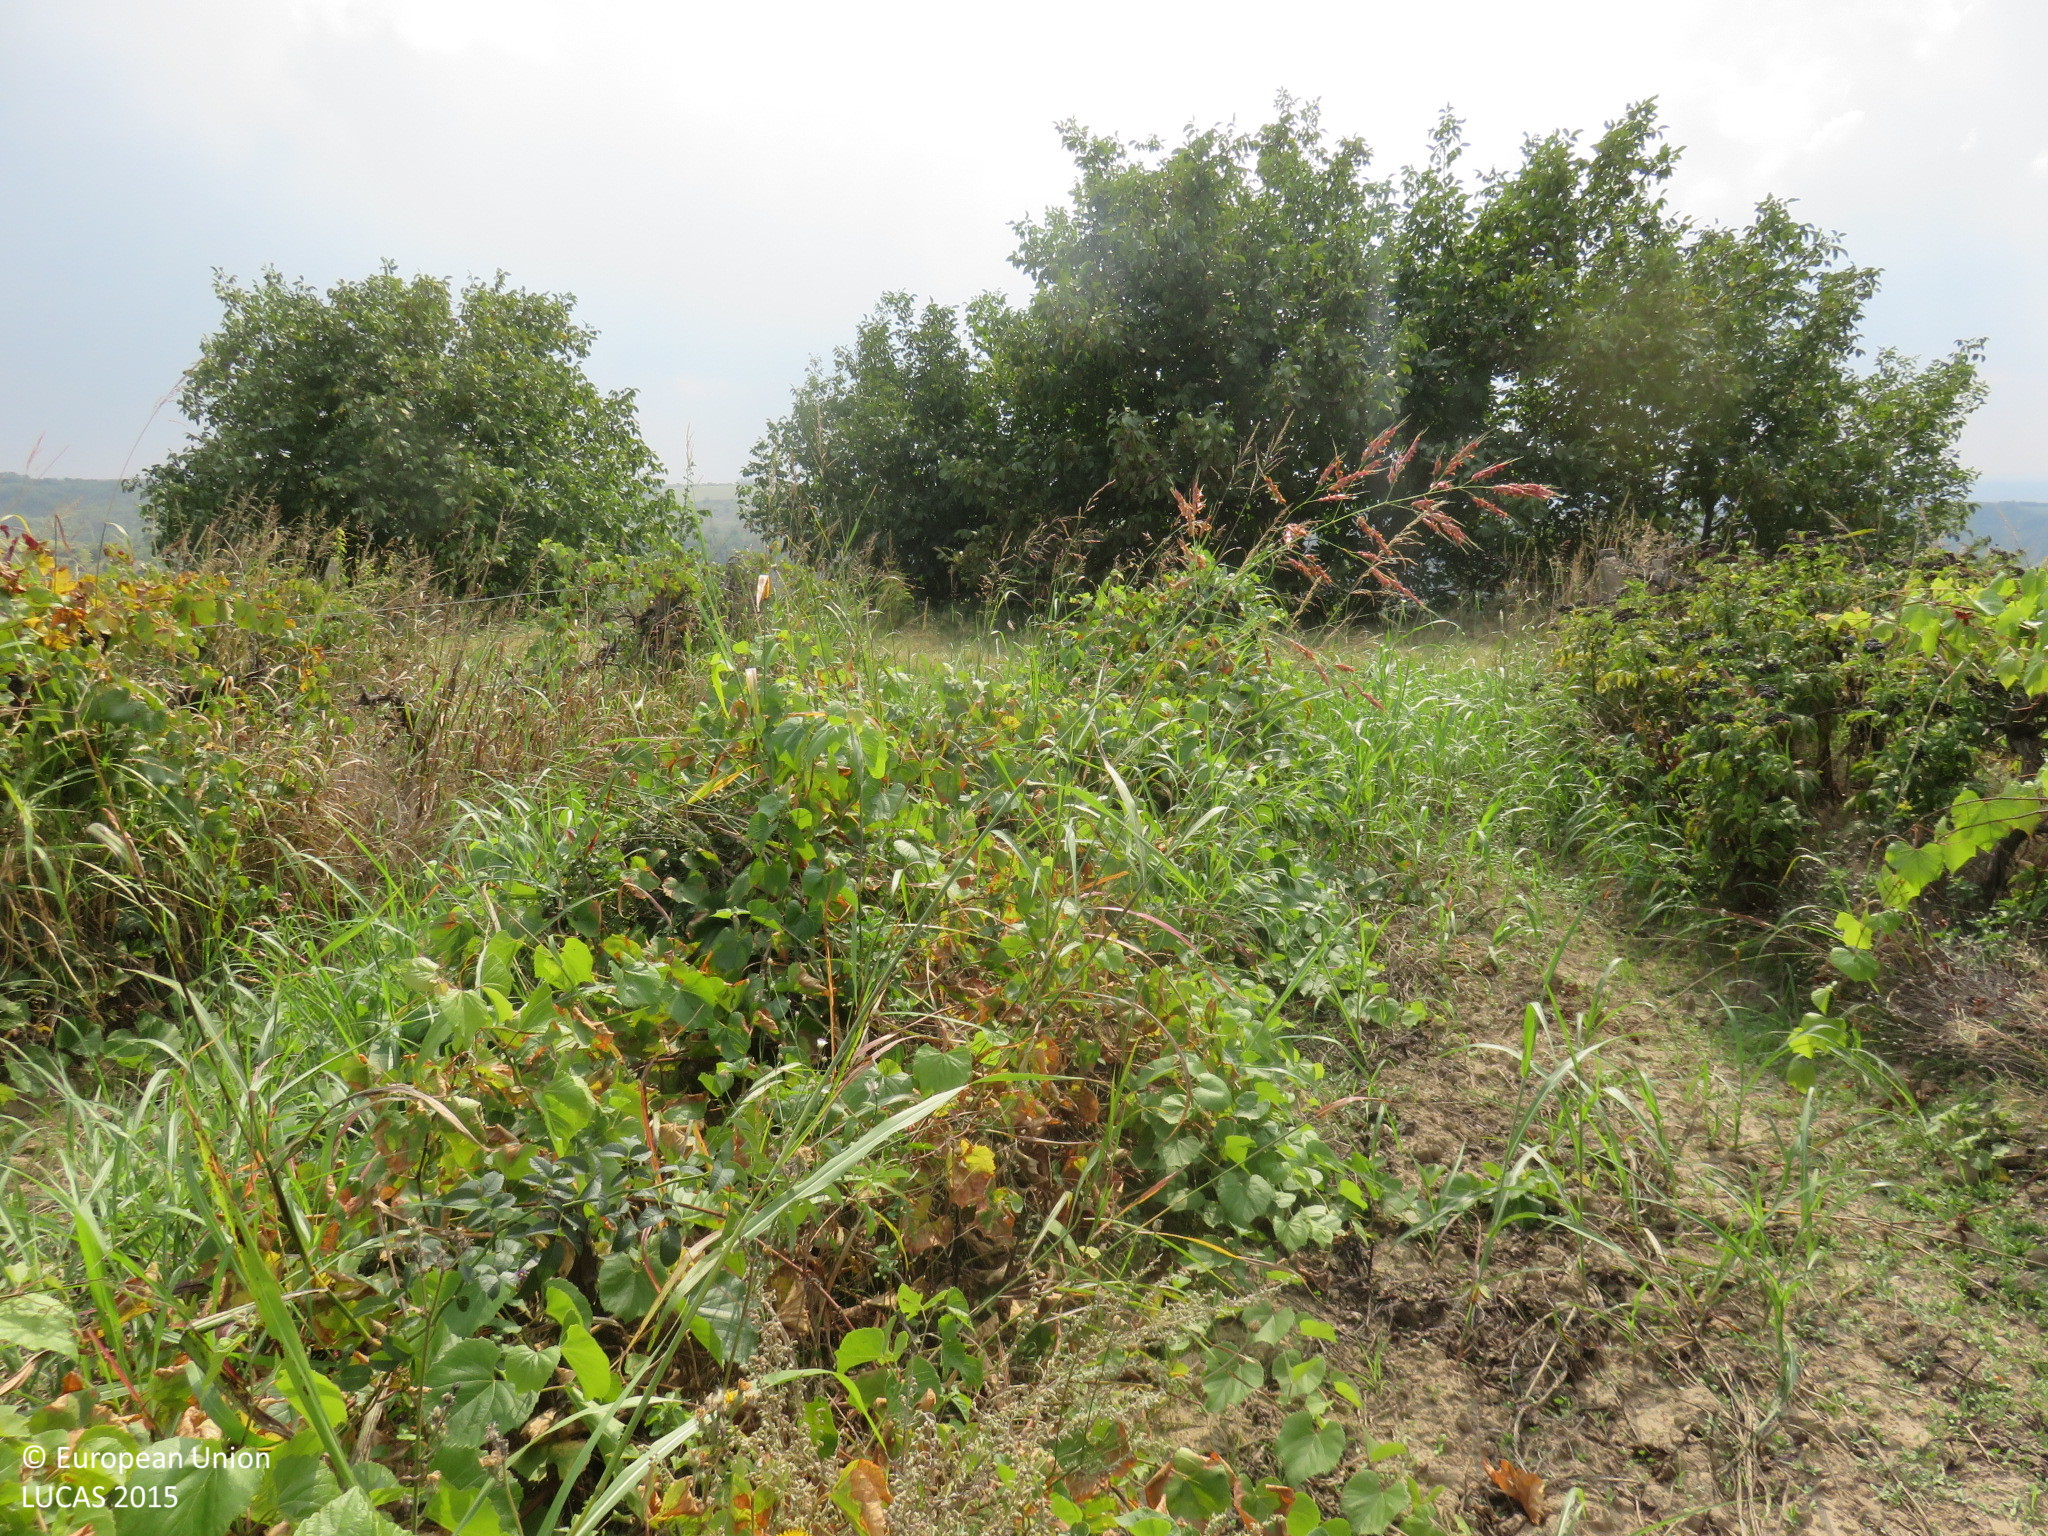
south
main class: Cropland
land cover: Vineyards
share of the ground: > 75 %
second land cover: Spontaneously vegetated surfaces
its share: 25 - 50 %
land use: Agriculture (excluding fallow land and kitchen gardens)
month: September
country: BG
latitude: 43.6118
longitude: 24.9270
